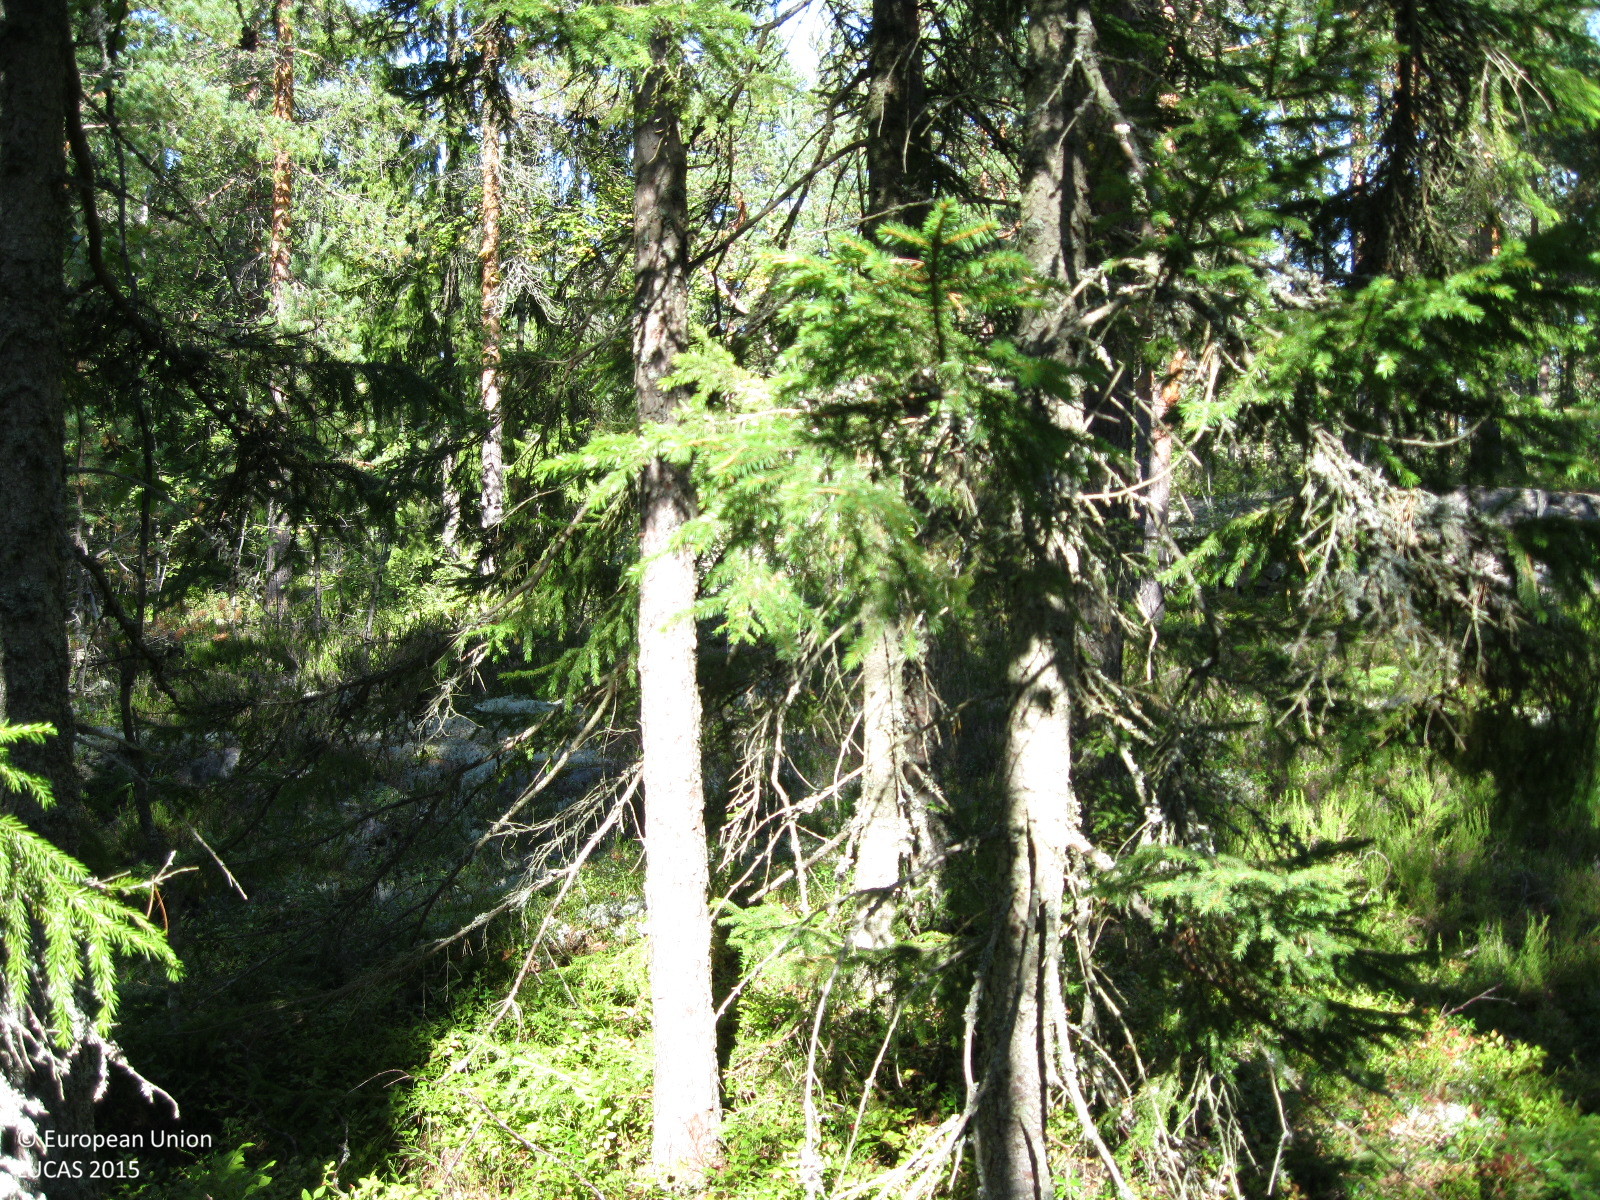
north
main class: Woodland
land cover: Pine dominated coniferous woodland
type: boreal forest
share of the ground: 50 - 75 %
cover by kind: coniferous forest trees 65 %, shrubs 15 %, herbaceous plants 15 %, broadleaved forest trees 5 %
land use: Forestry
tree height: > 5 m
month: September
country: FI
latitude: 60.6320
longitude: 24.9026
